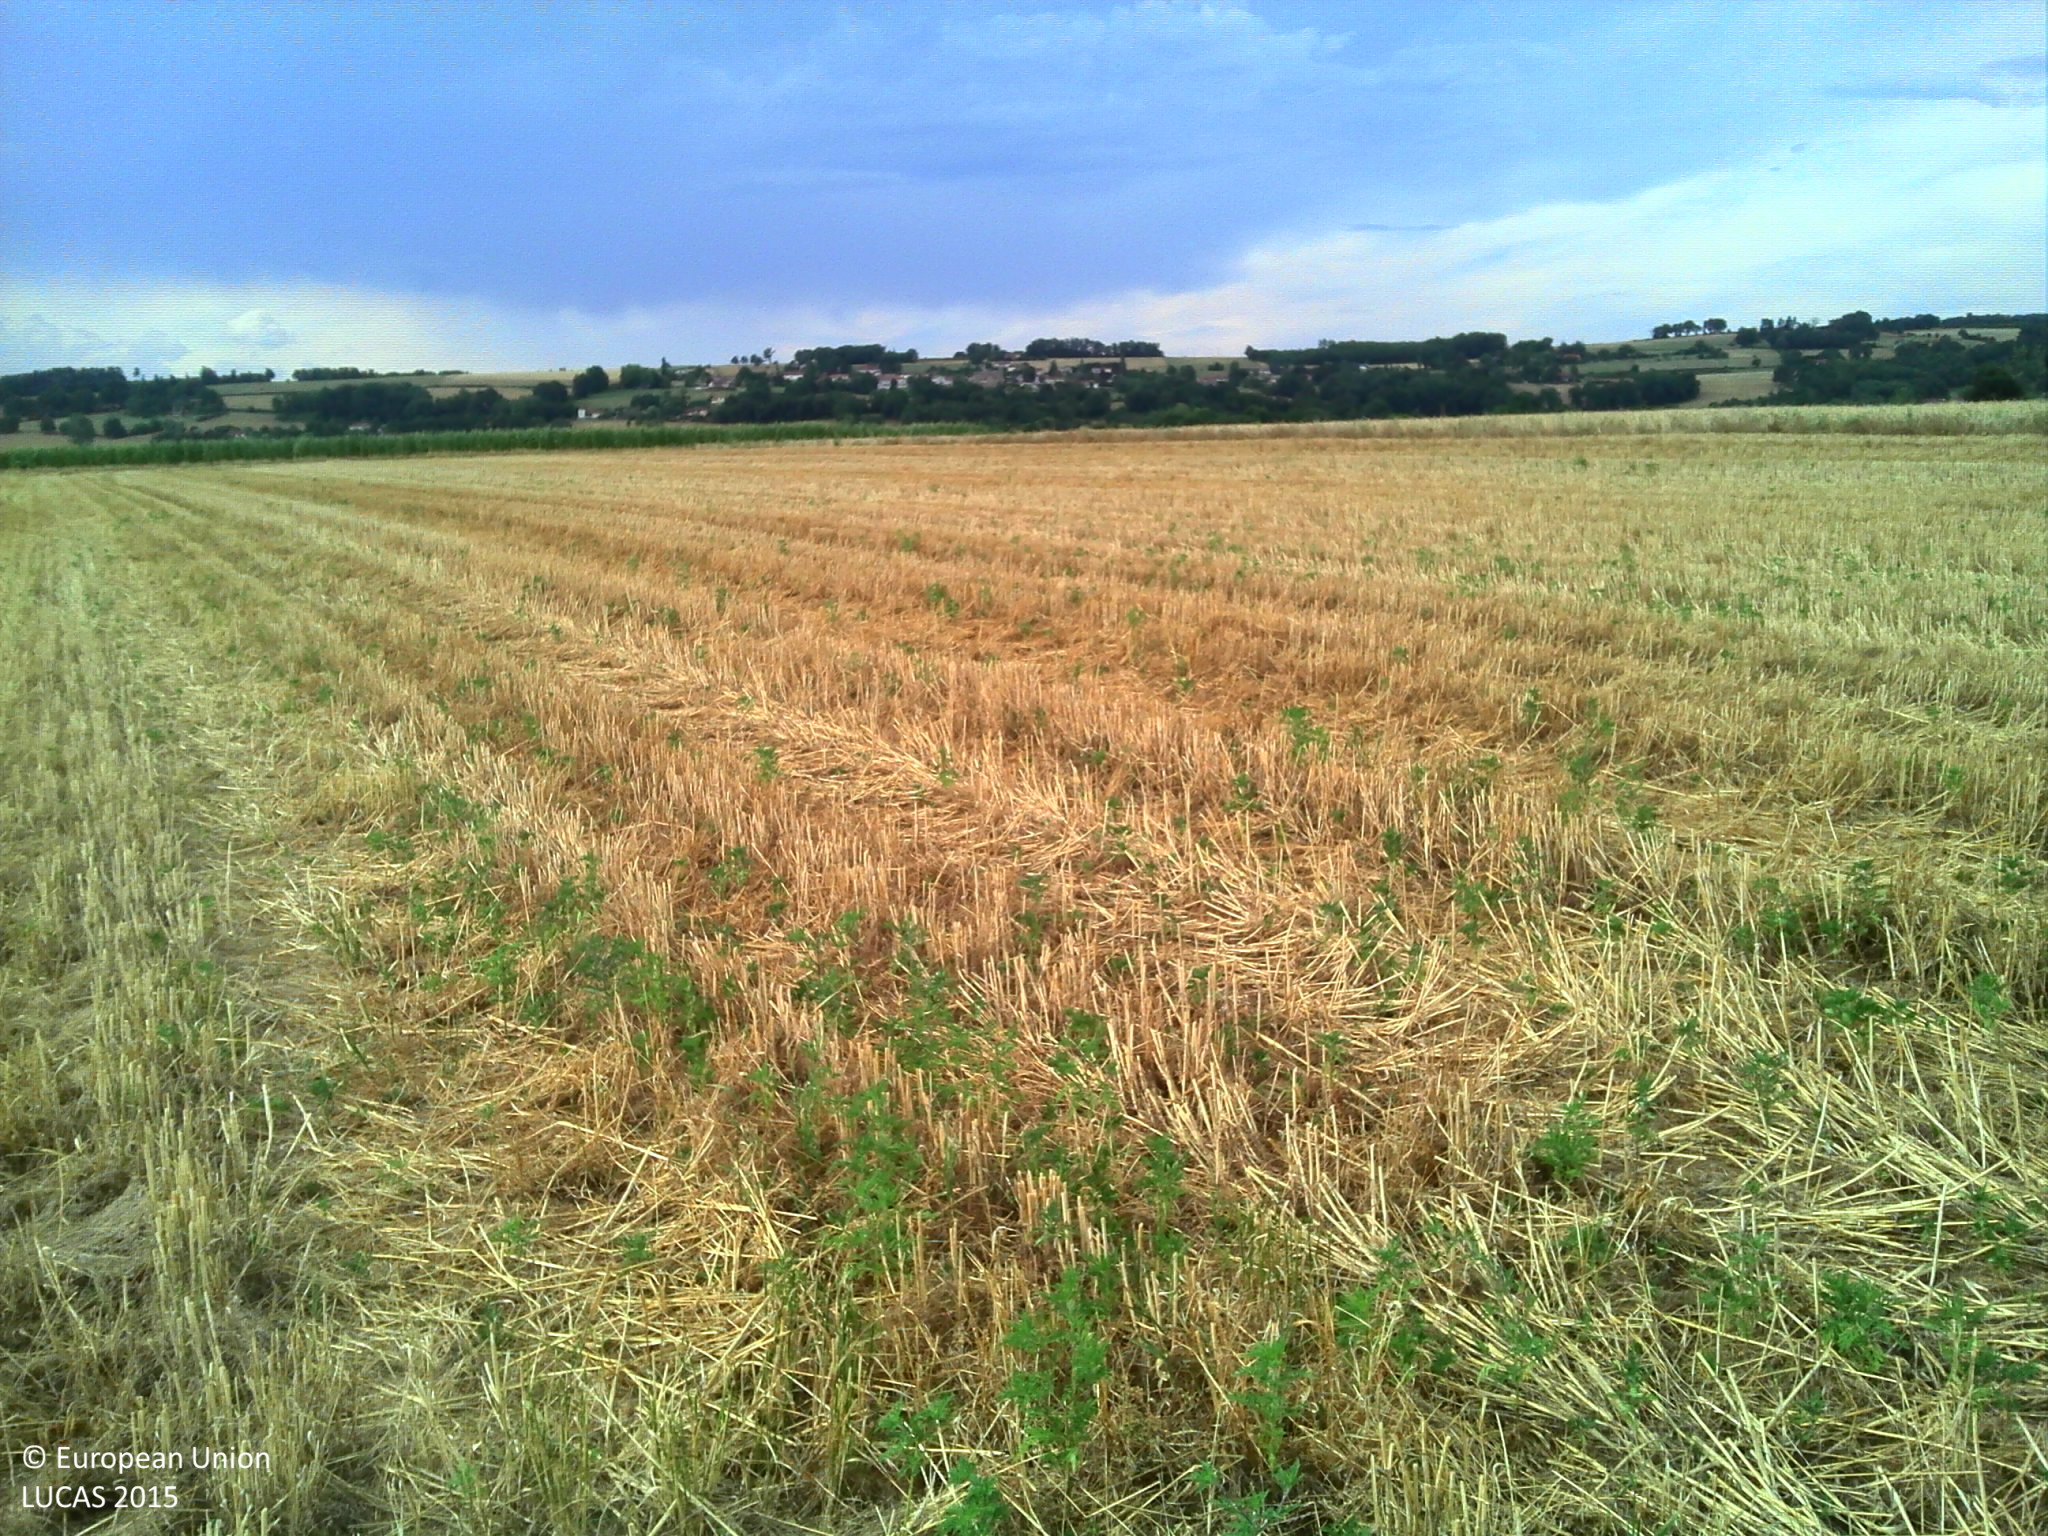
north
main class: Cropland
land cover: Common wheat
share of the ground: > 75 %
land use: Agriculture (excluding fallow land and kitchen gardens)
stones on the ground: < 10 %
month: July
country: FR
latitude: 45.3709
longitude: 5.0633
